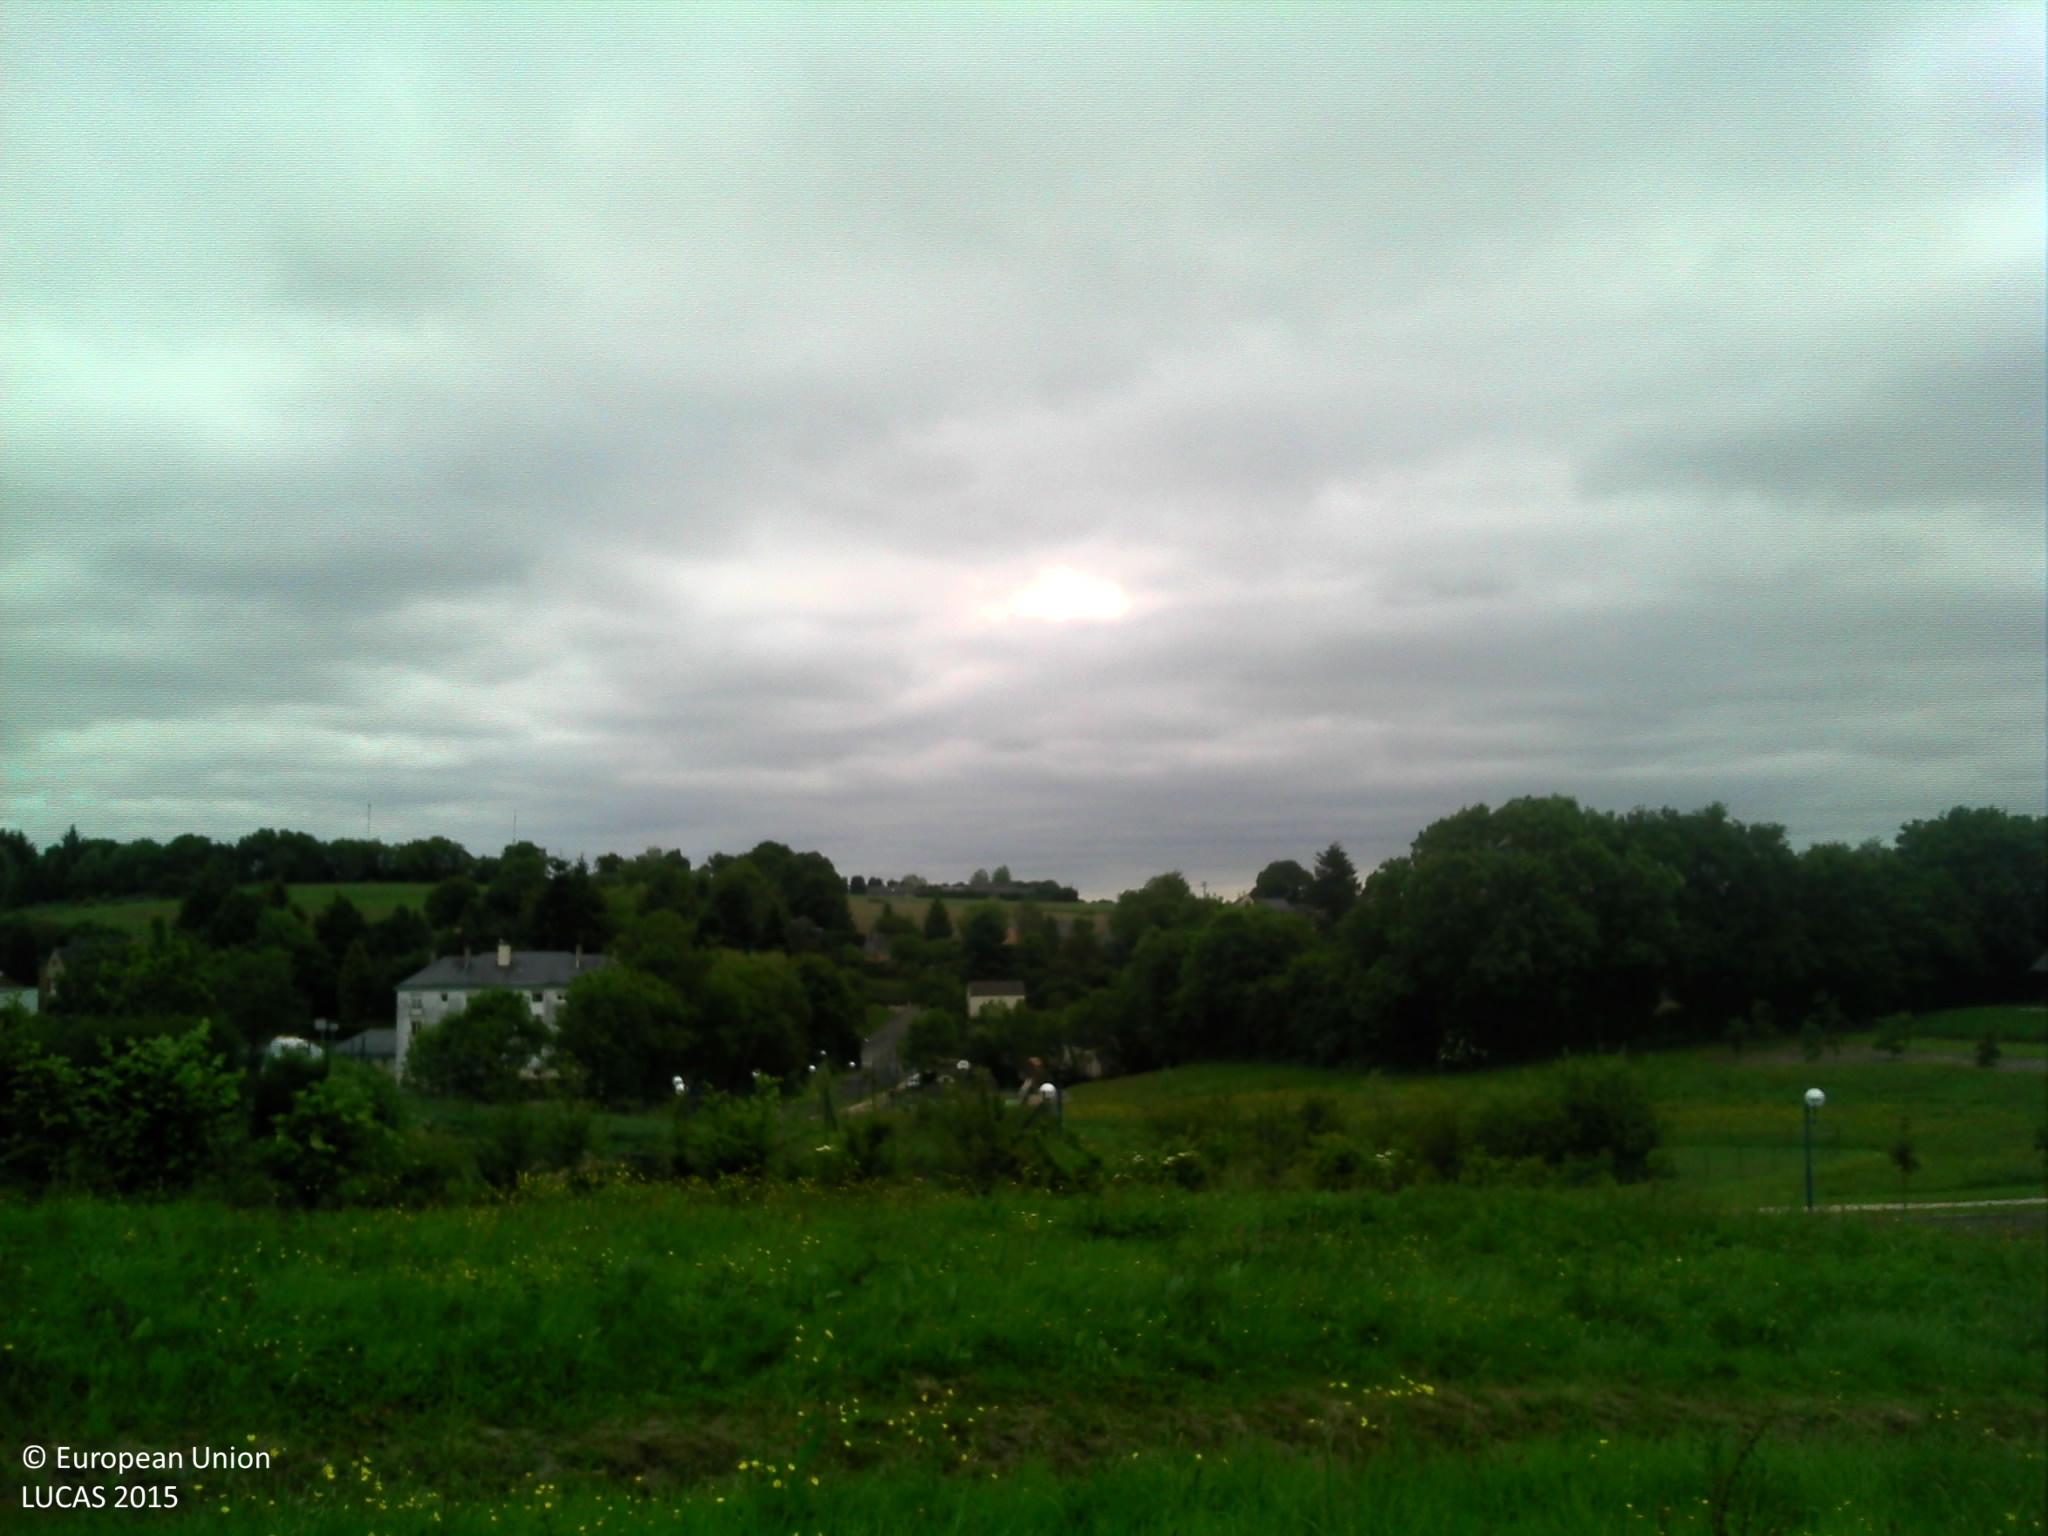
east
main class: Grassland
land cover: Grassland without tree/shrub cover
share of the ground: > 75 %
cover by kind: herbaceous plants 100 %
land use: Residential
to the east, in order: Grassland without tree/shrub cover; Dry stone walls; Paved roads, cycling and walking lanes; Grass margins; Fences; Ponds and wetlands; Fences; Grassland without tree/shrub cover; Broadleaved woodland; Fences; Grassland without tree/shrub cover; Fences; Broadleaved woodland; Artificial constructions in urban areas
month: May
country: FR
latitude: 48.1907
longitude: -0.1325
